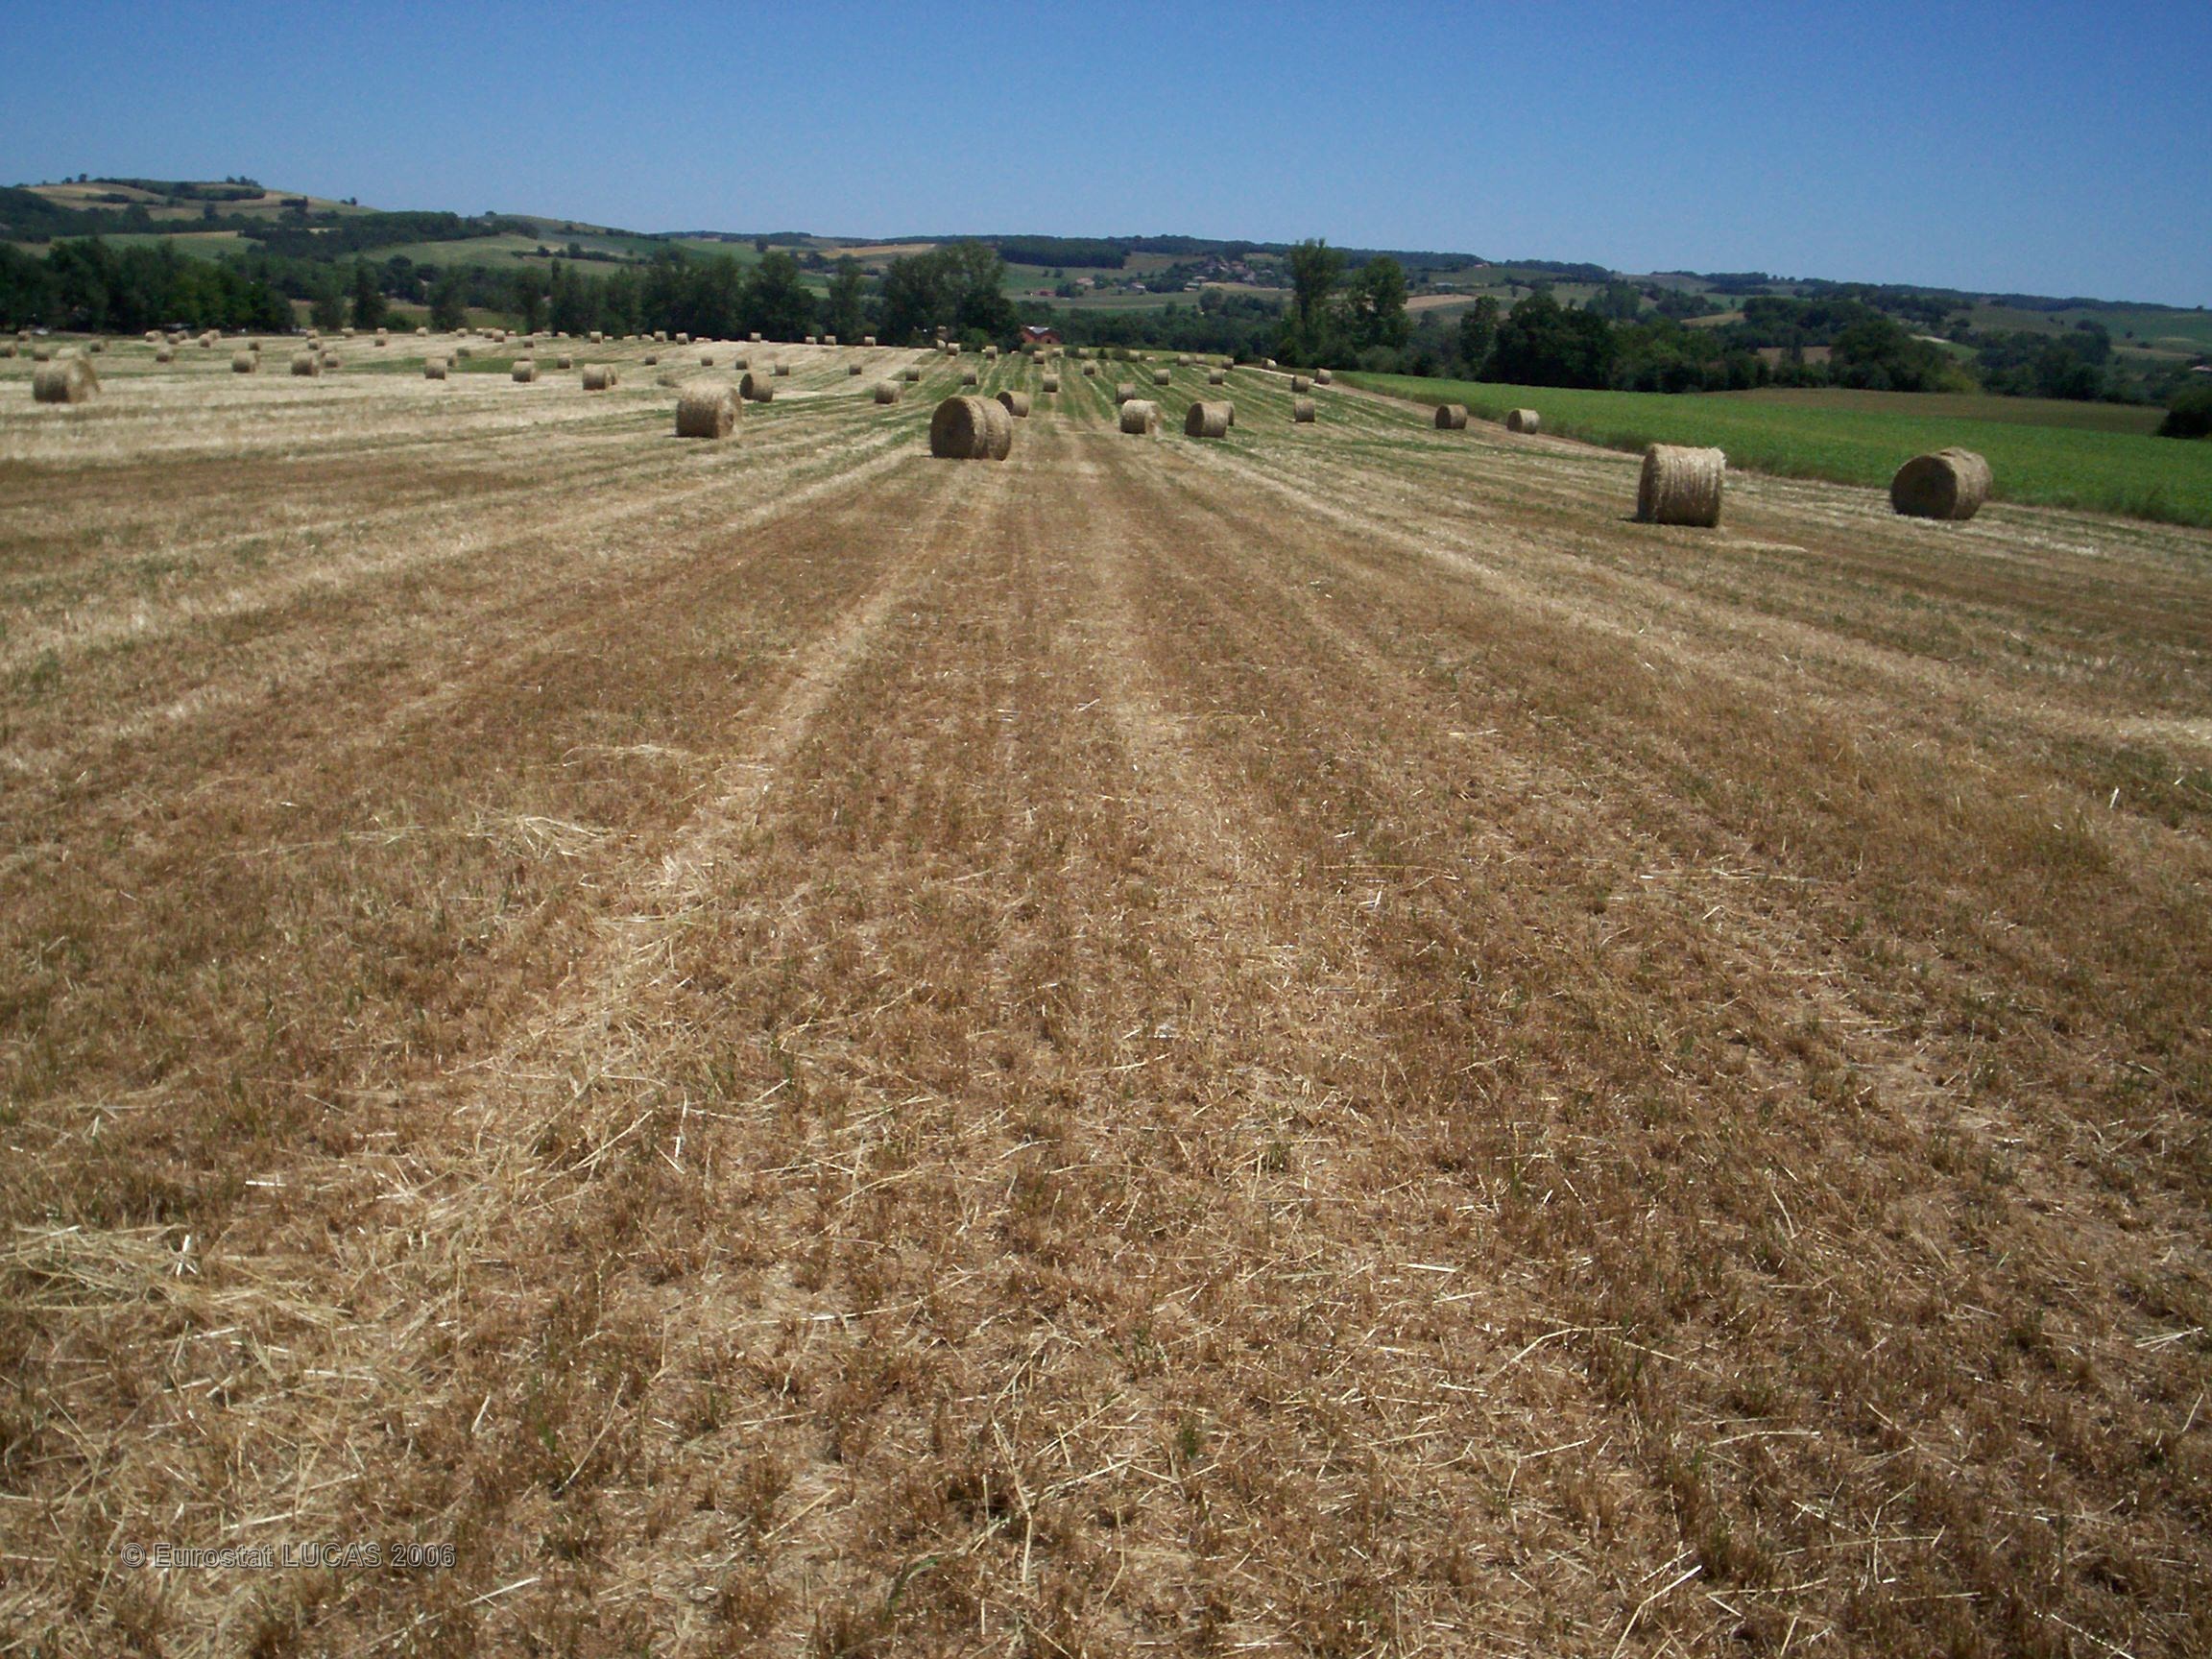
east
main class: Grassland
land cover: Grassland without tree/shrub cover
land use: Agriculture (excluding fallow land and kitchen gardens)
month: June
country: FR
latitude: 43.9961
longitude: 0.8066
